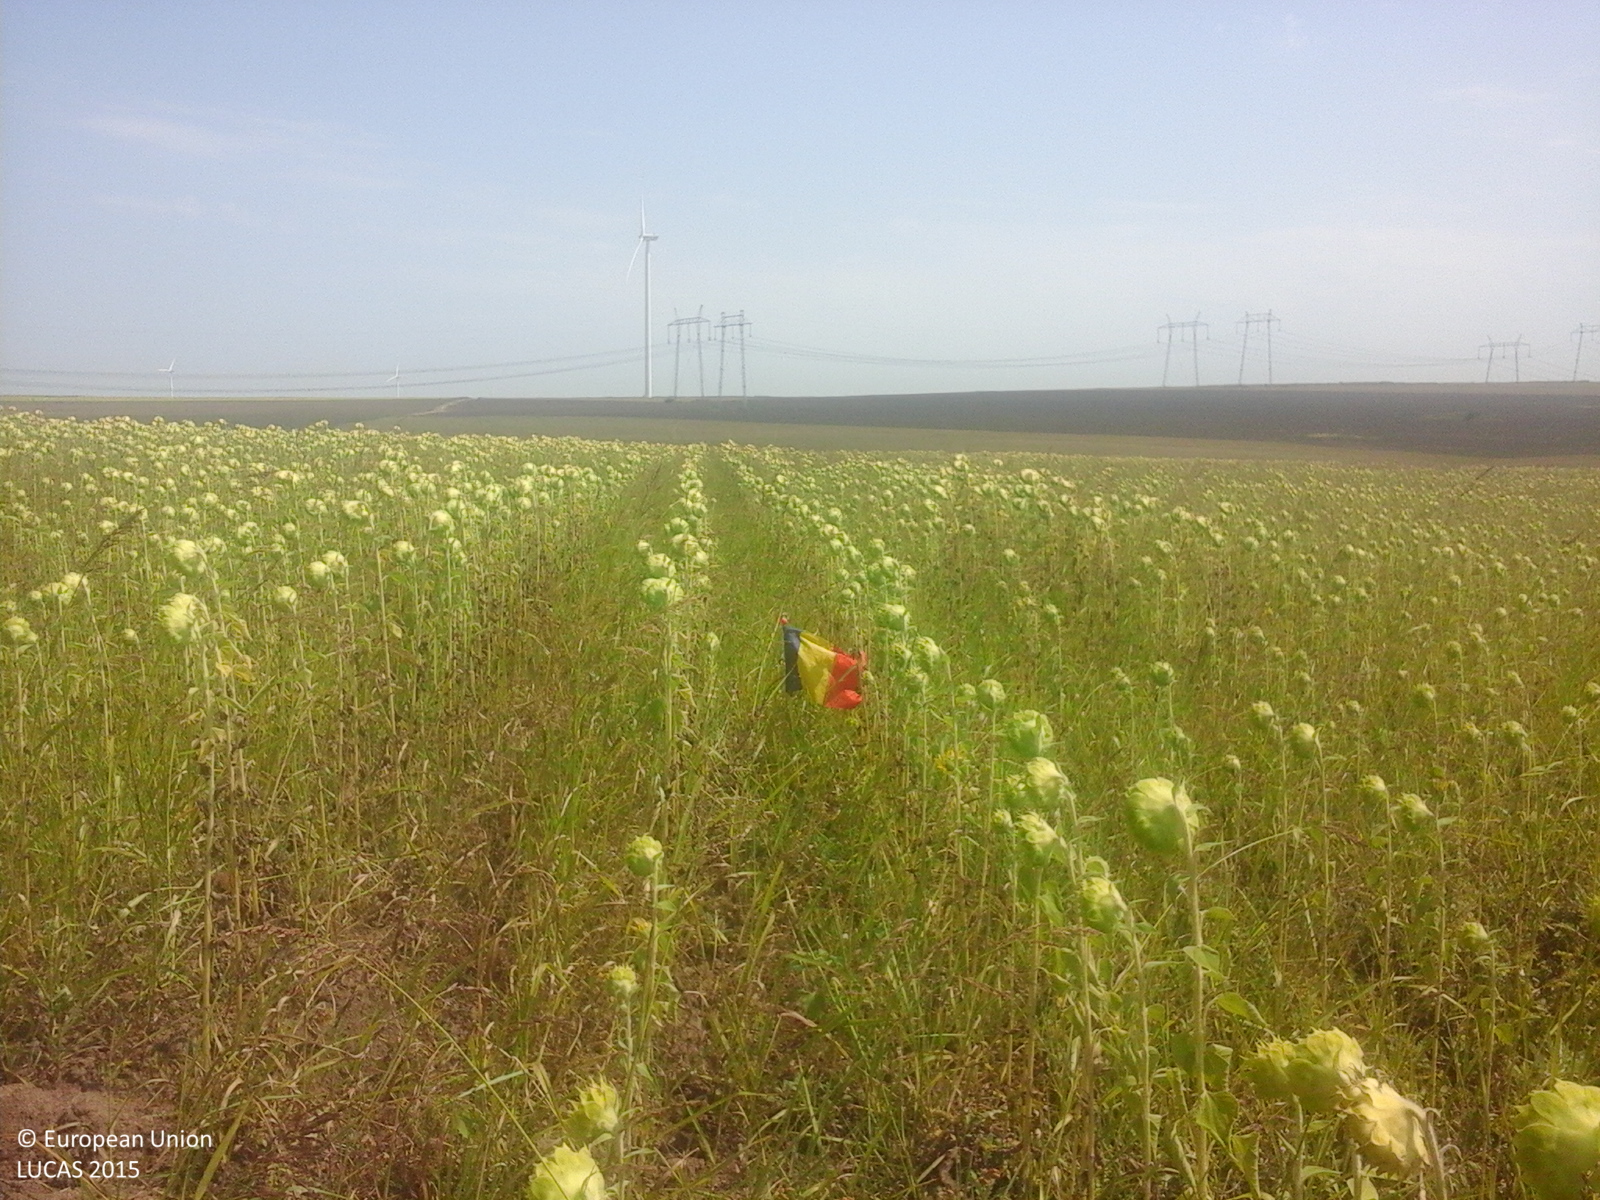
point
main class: Cropland
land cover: Sunflower
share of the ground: > 75 %
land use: Agriculture (excluding fallow land and kitchen gardens)
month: August
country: RO
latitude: 44.3066
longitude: 28.1229
